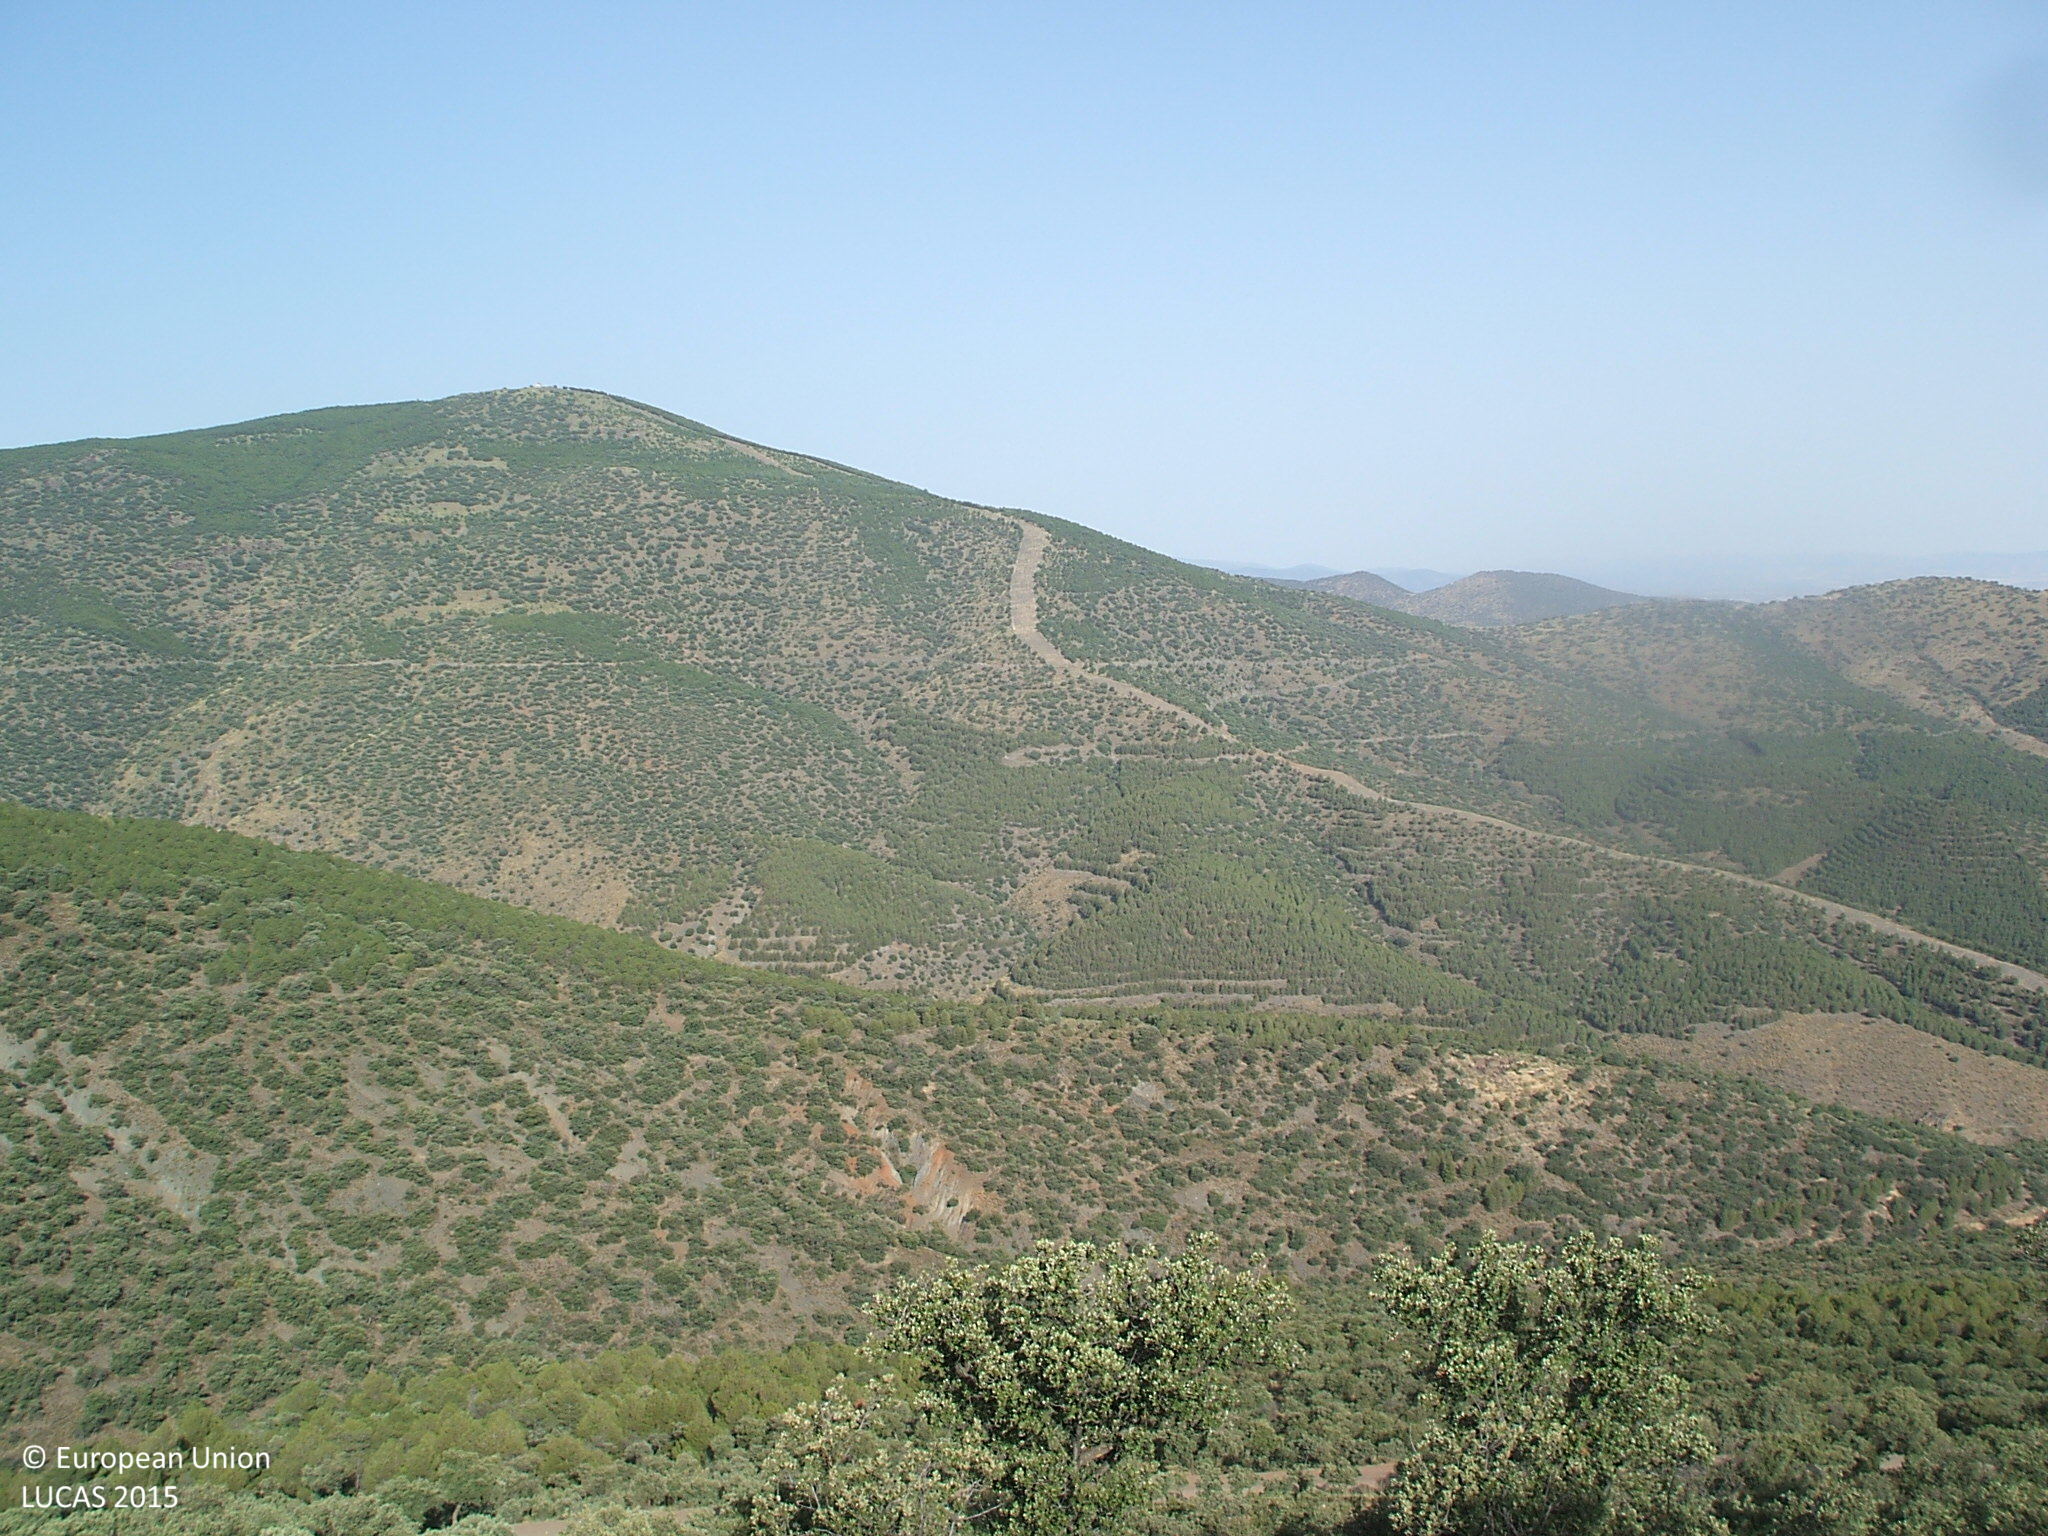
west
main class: Woodland
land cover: Broadleaved woodland
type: broadleaved evergreen forest
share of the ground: 10 - 25 %
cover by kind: shrubs 80 %, broadleaved forest trees 20 %
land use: Semi-natural and natural areas not in use
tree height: < 5 m
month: June
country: ES
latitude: 37.1407
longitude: -2.8954
